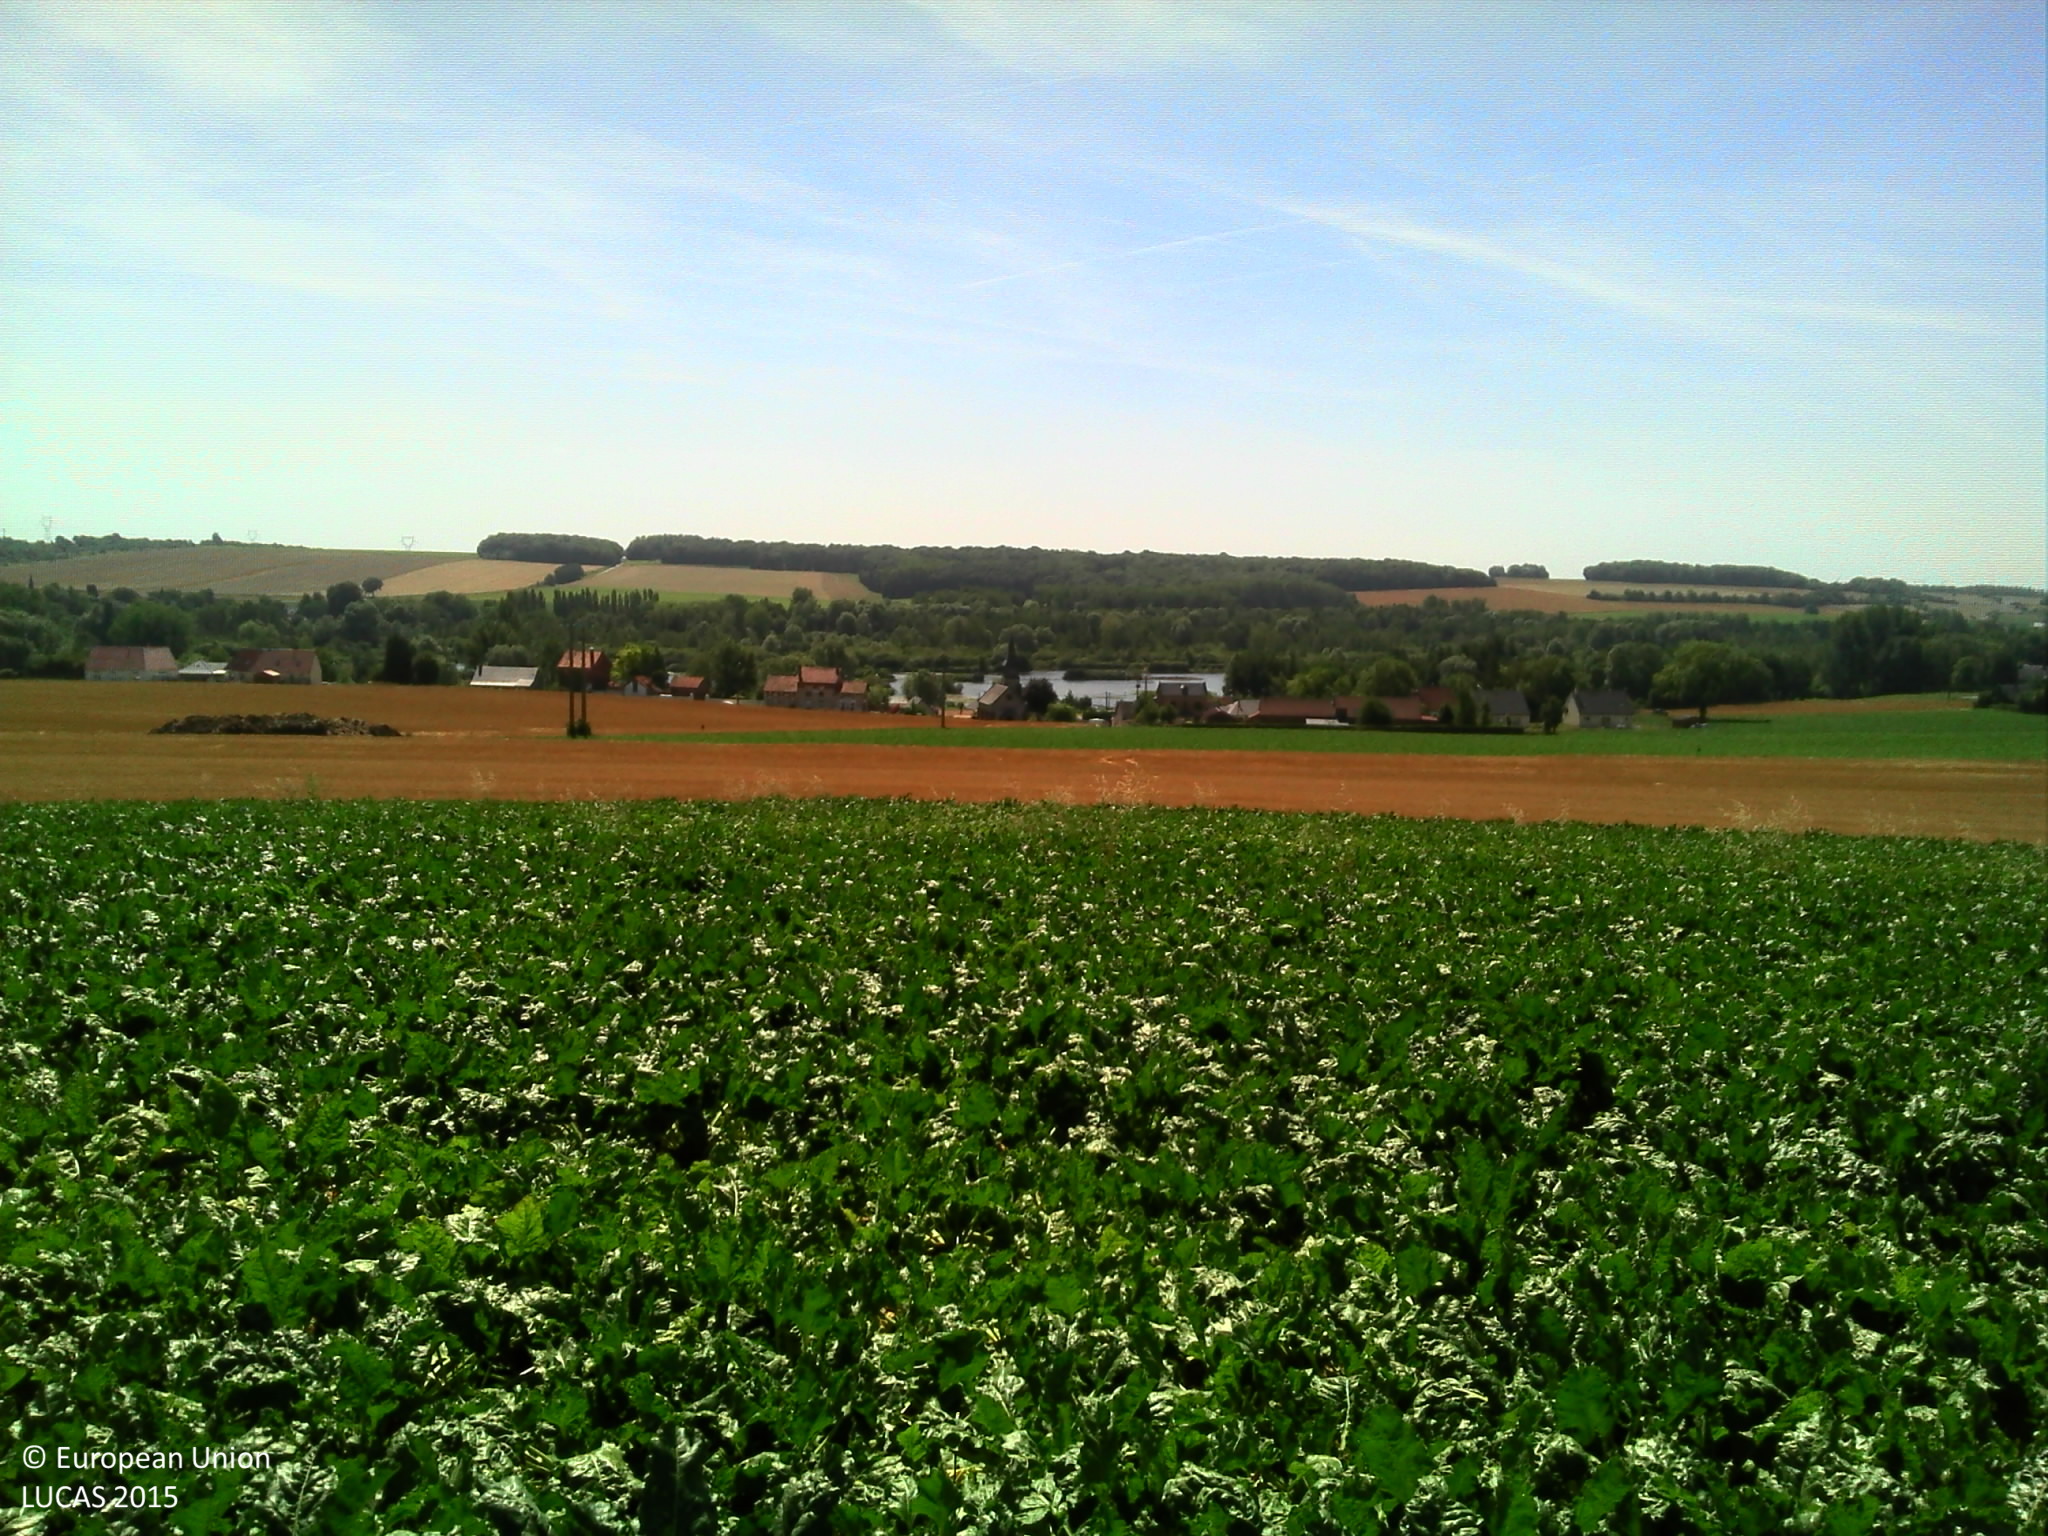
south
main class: Cropland
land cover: Sugar beet
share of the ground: > 75 %
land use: Agriculture (excluding fallow land and kitchen gardens)
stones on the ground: 25 - 50 %
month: August
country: FR
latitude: 49.9590
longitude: 2.8386
